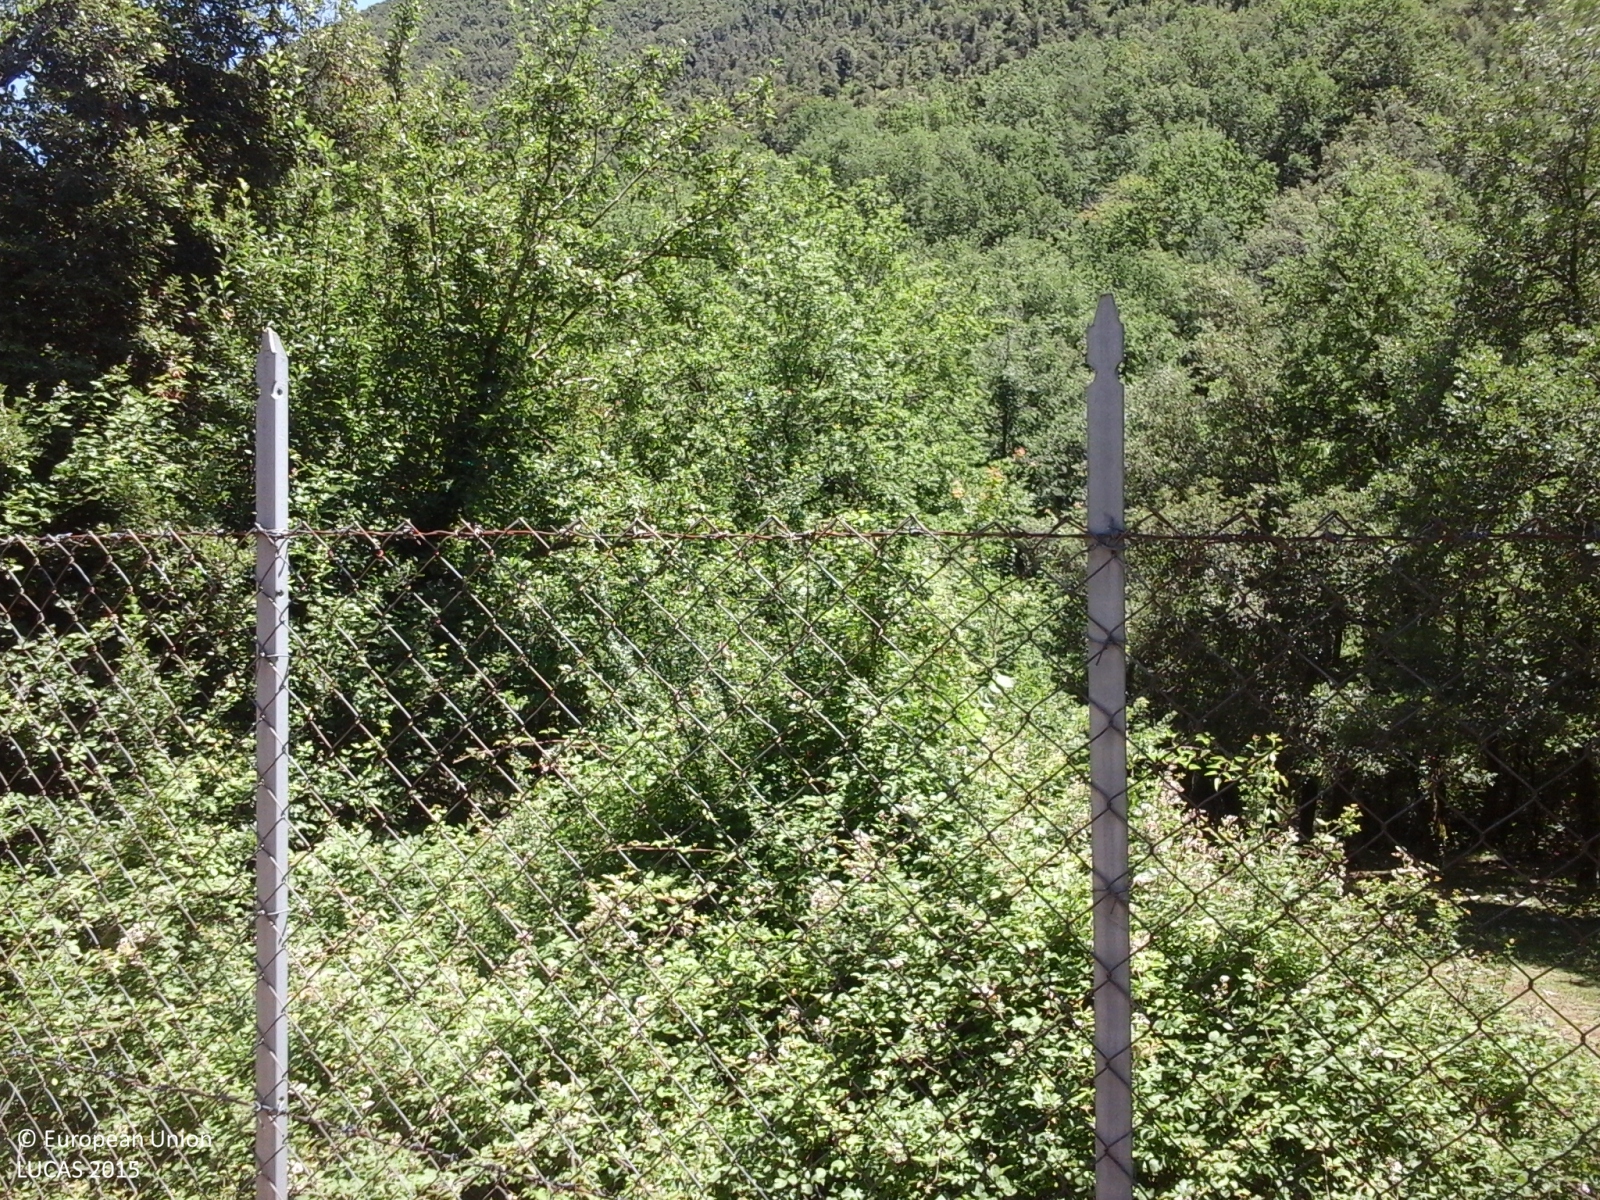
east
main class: Woodland
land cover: Broadleaved woodland
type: thermophilous deciduous forest
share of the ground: > 75 %
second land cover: Grassland without tree/shrub cover
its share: > 75 %
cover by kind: broadleaved forest trees 70 %, herbaceous plants 30 %
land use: Forestry
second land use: Agriculture (excluding fallow land and kitchen gardens)
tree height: > 5 m
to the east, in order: Broadleaved woodland; Grassland without tree/shrub cover; Rivers and streams; Broadleaved woodland; Electric lines; Broadleaved woodland
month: June
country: IT
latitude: 41.6311
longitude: 13.0732
